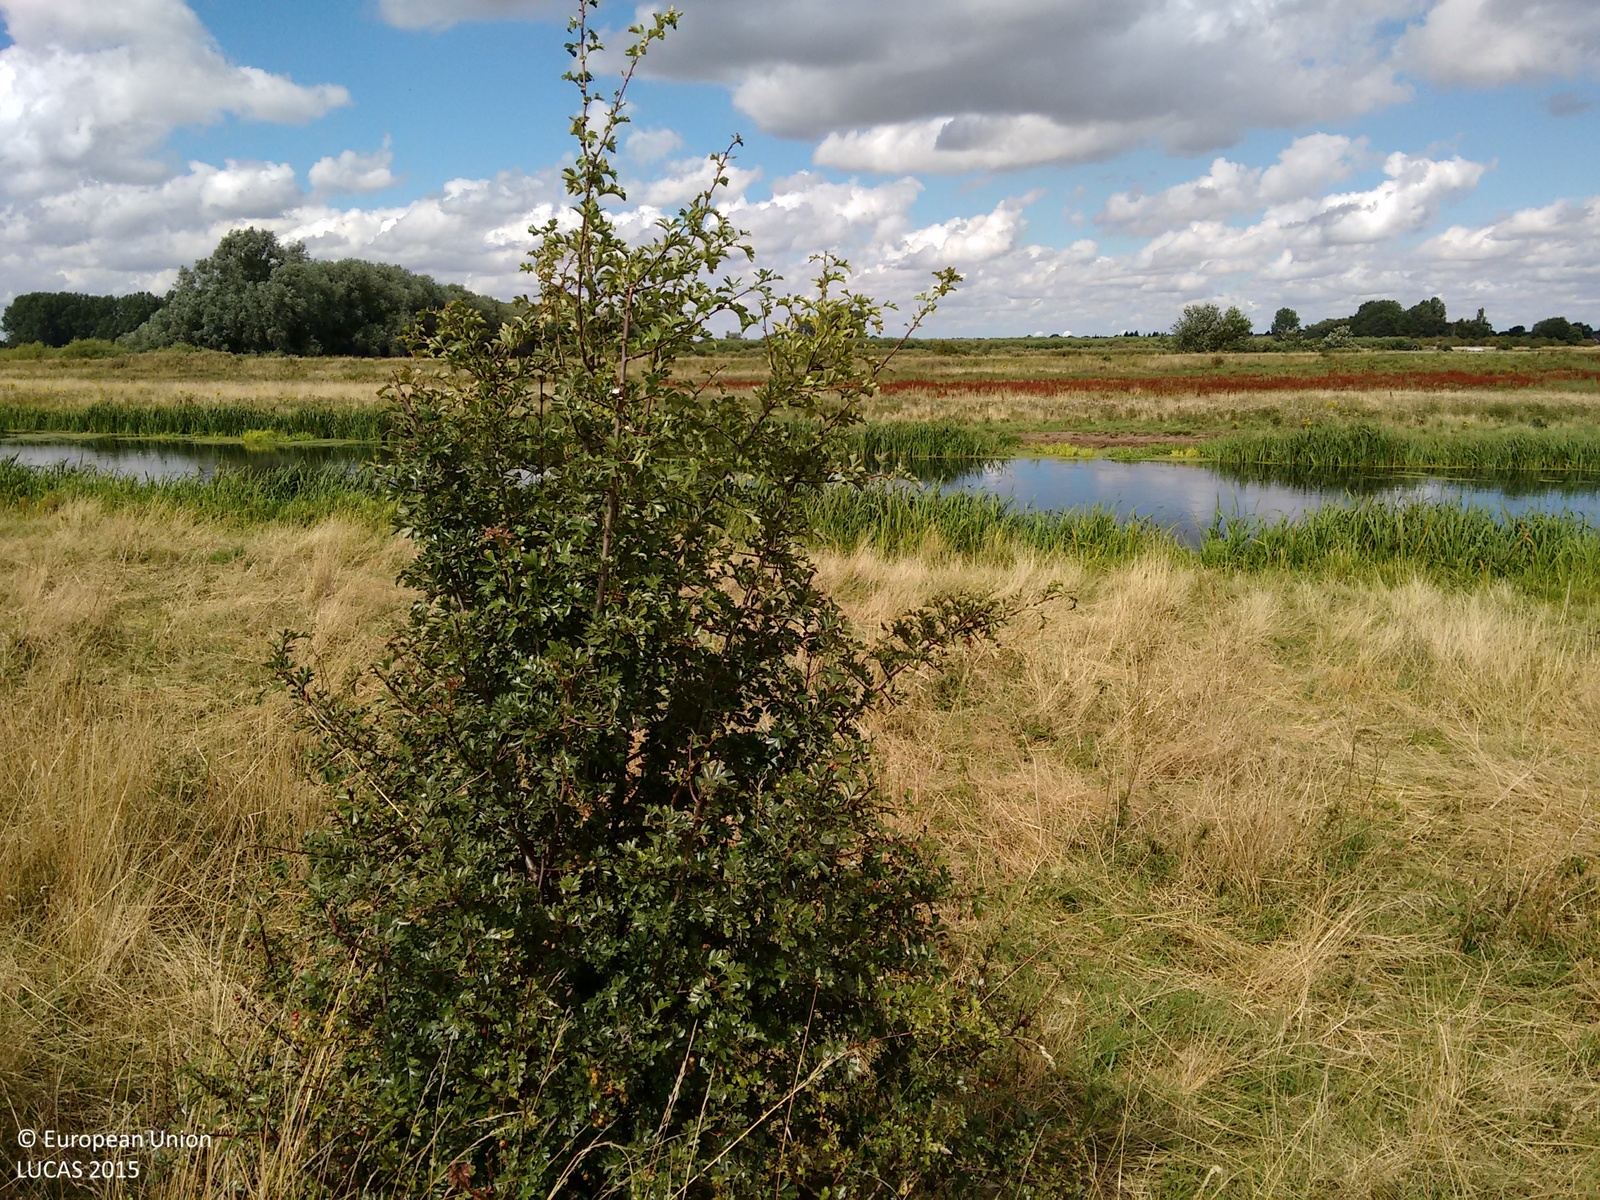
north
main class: Grassland
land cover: Grassland with sparse tree/shrub cover
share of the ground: > 75 %
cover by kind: herbaceous plants 95 %, broadleaved forest trees 5 %
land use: Agriculture (excluding fallow land and kitchen gardens)
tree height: < 5 m
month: August
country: GB
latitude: 52.4493
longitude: 0.5116
